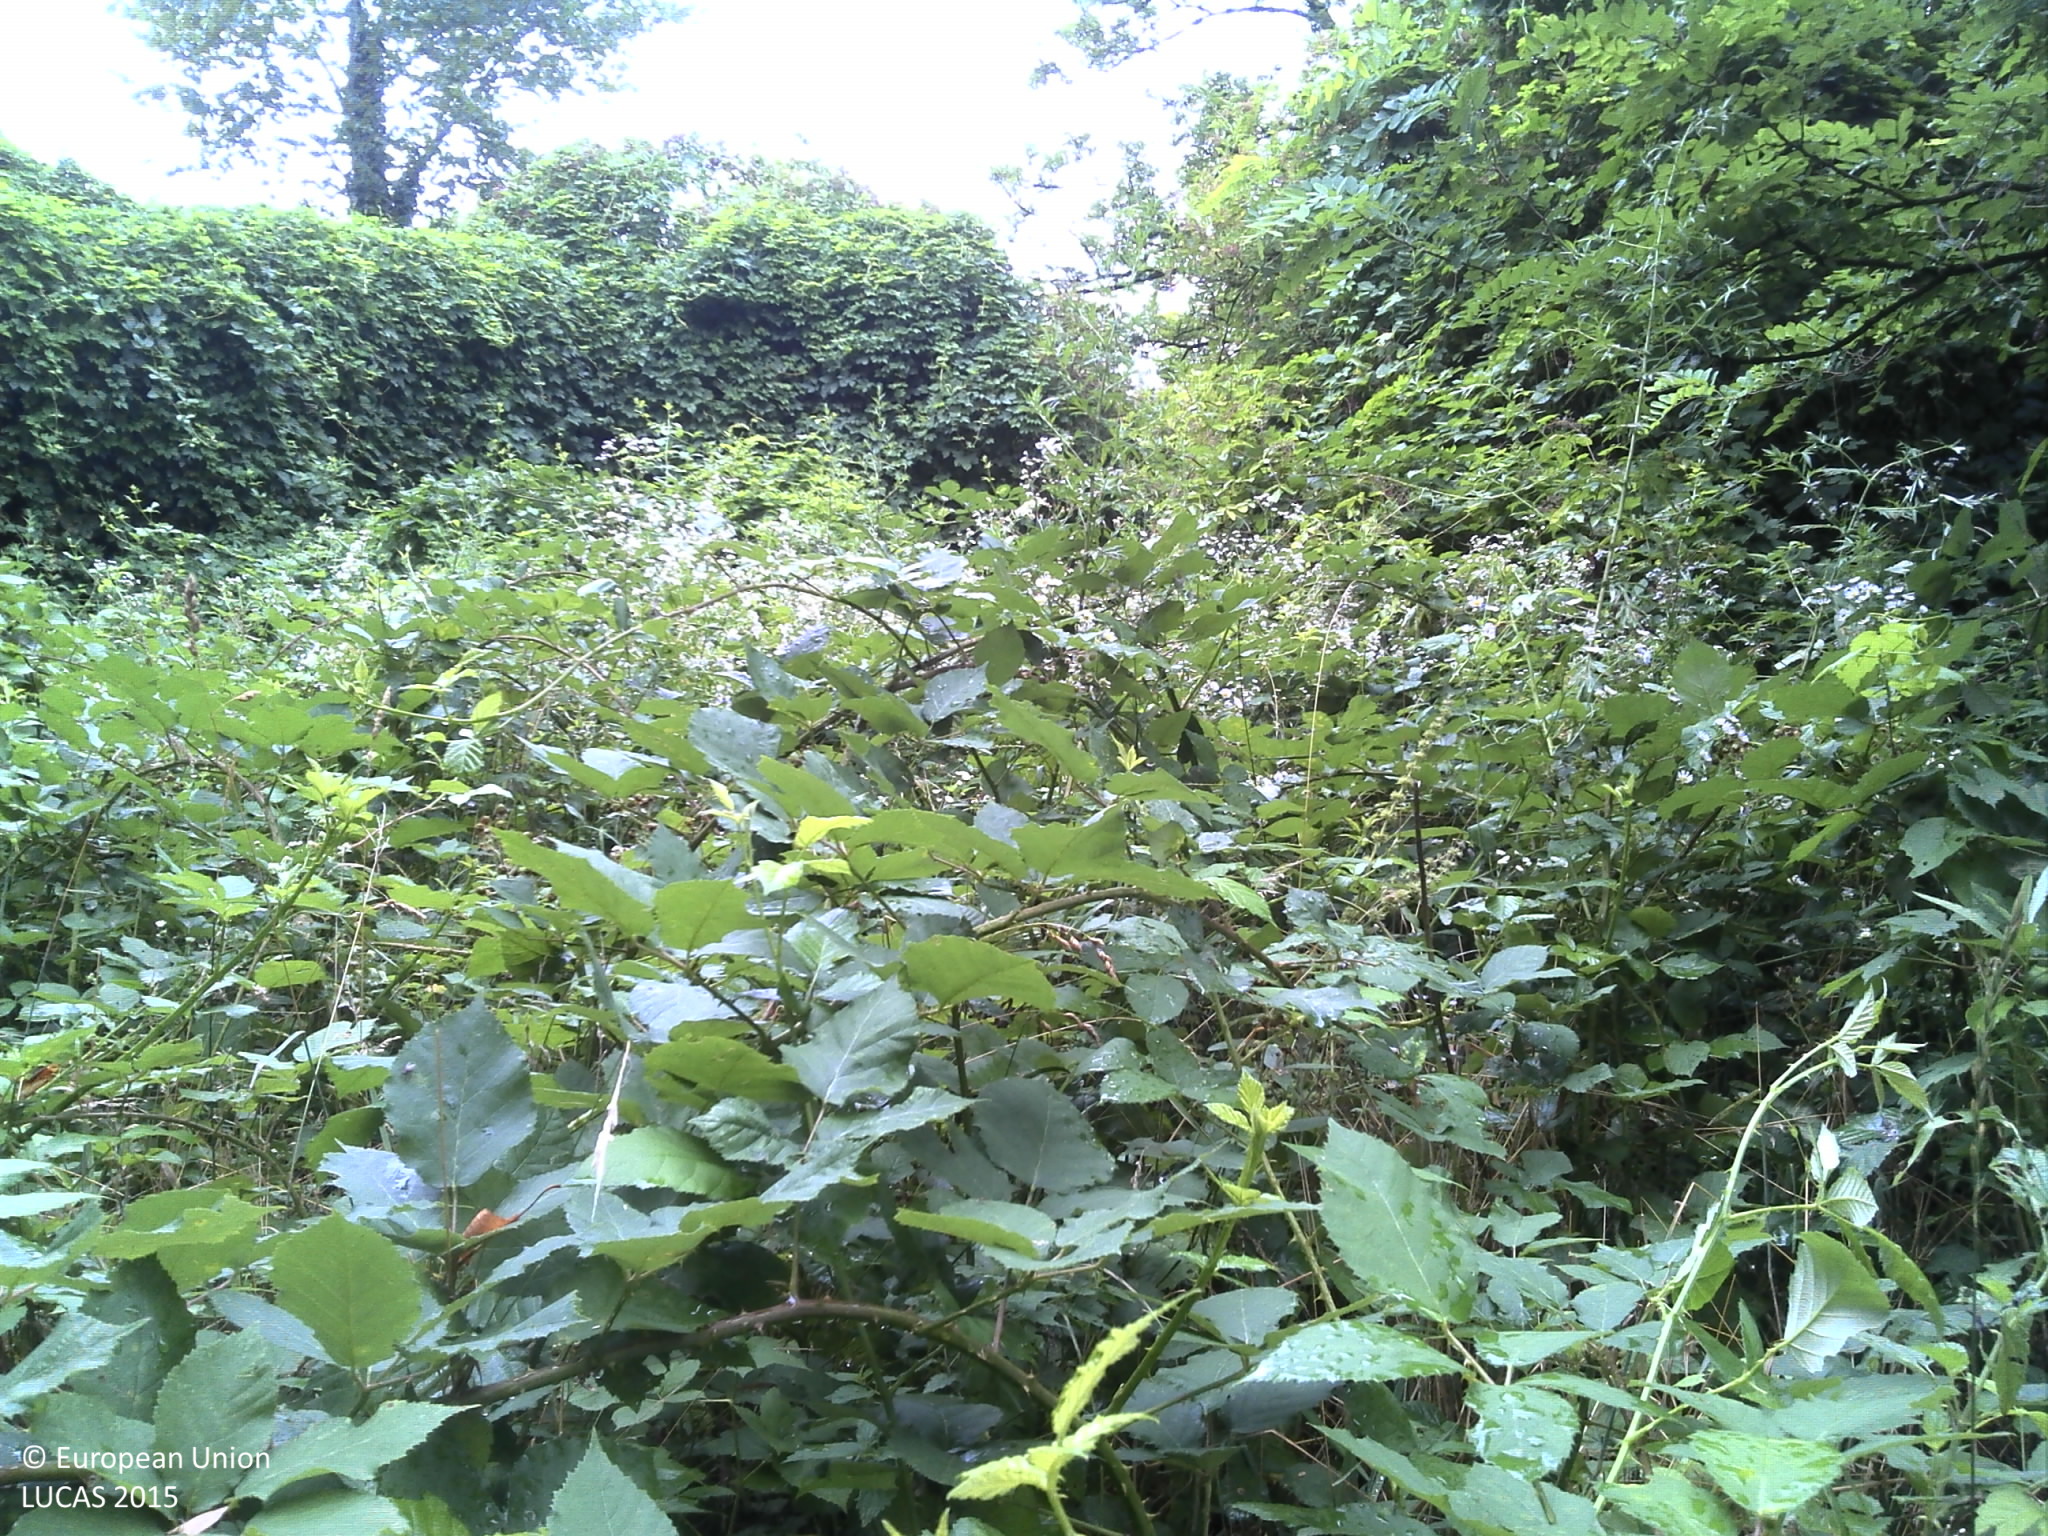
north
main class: Grassland
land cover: Spontaneously vegetated surfaces
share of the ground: > 75 %
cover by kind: herbaceous plants 95 %, shrubs 5 %
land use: Semi-natural and natural areas not in use
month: July
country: HR
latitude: 45.8919
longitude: 16.9212
